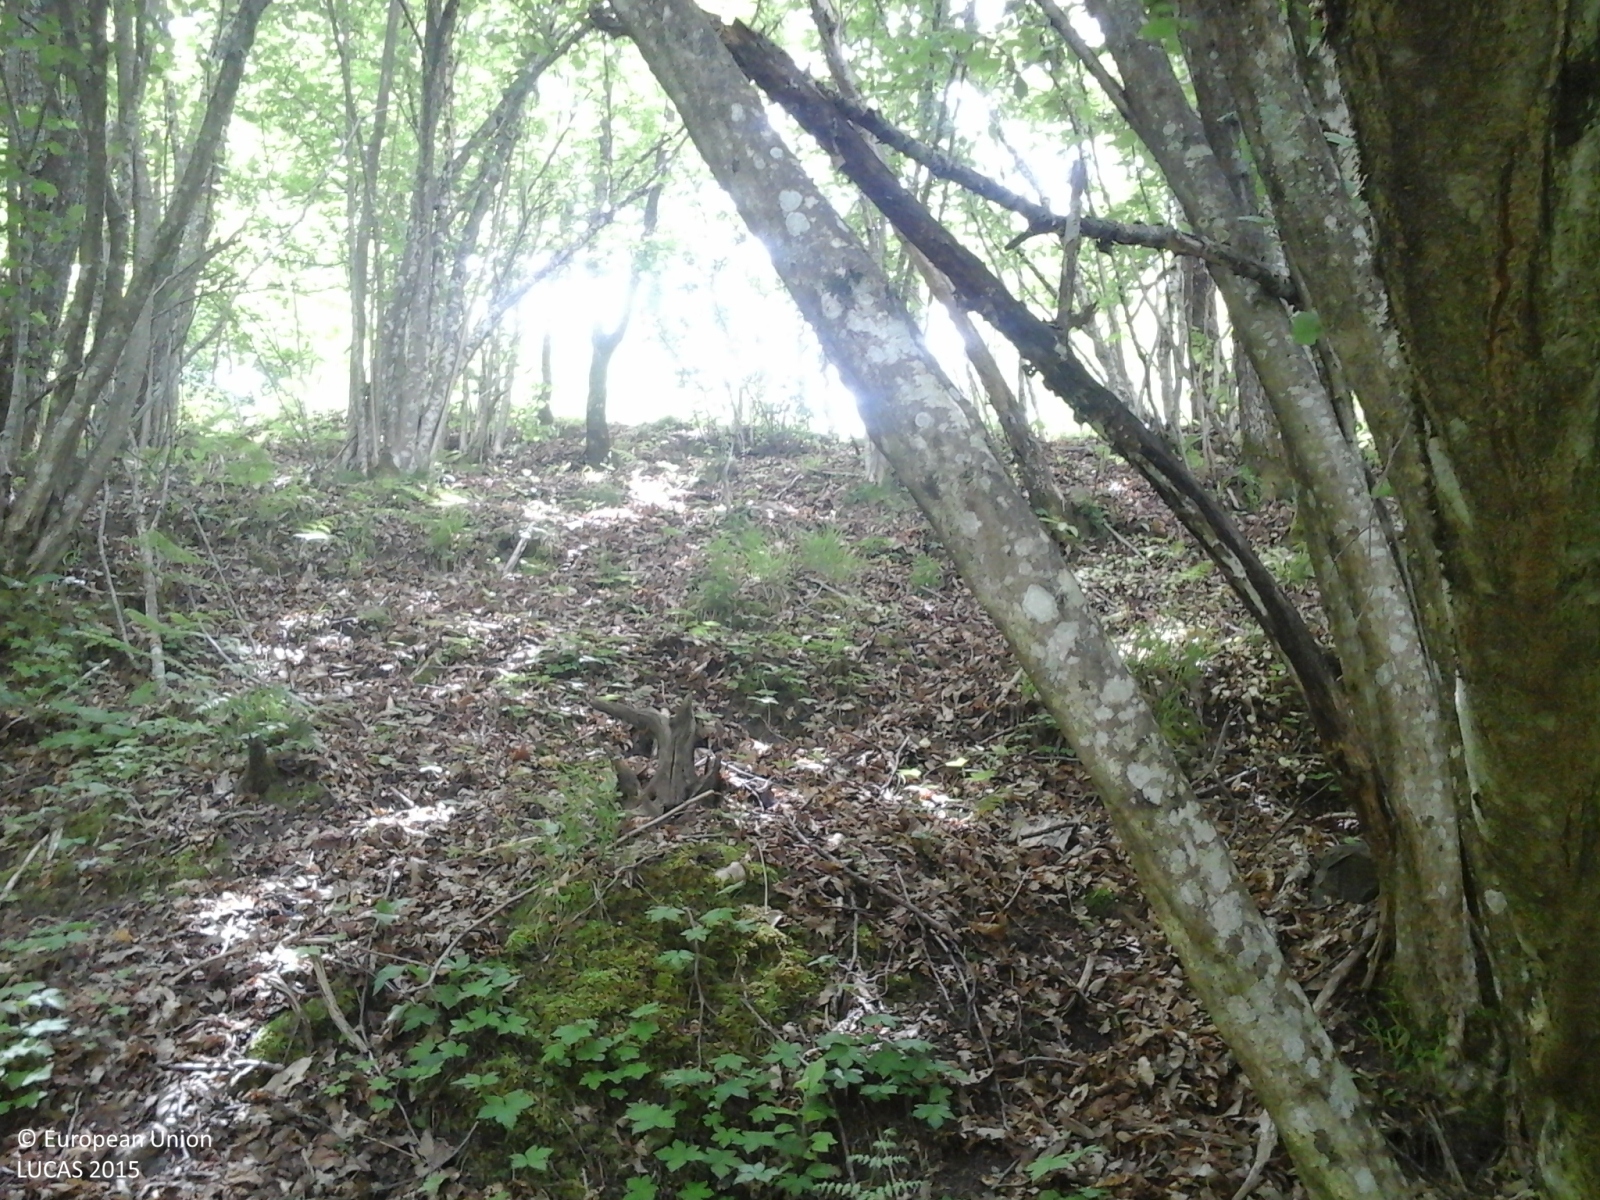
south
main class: Woodland
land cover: Broadleaved woodland
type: thermophilous deciduous forest
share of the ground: > 75 %
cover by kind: broadleaved forest trees 80 %, herbaceous plants 20 %
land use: Forestry
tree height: > 5 m
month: May
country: IT
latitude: 44.4222
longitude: 9.6867
